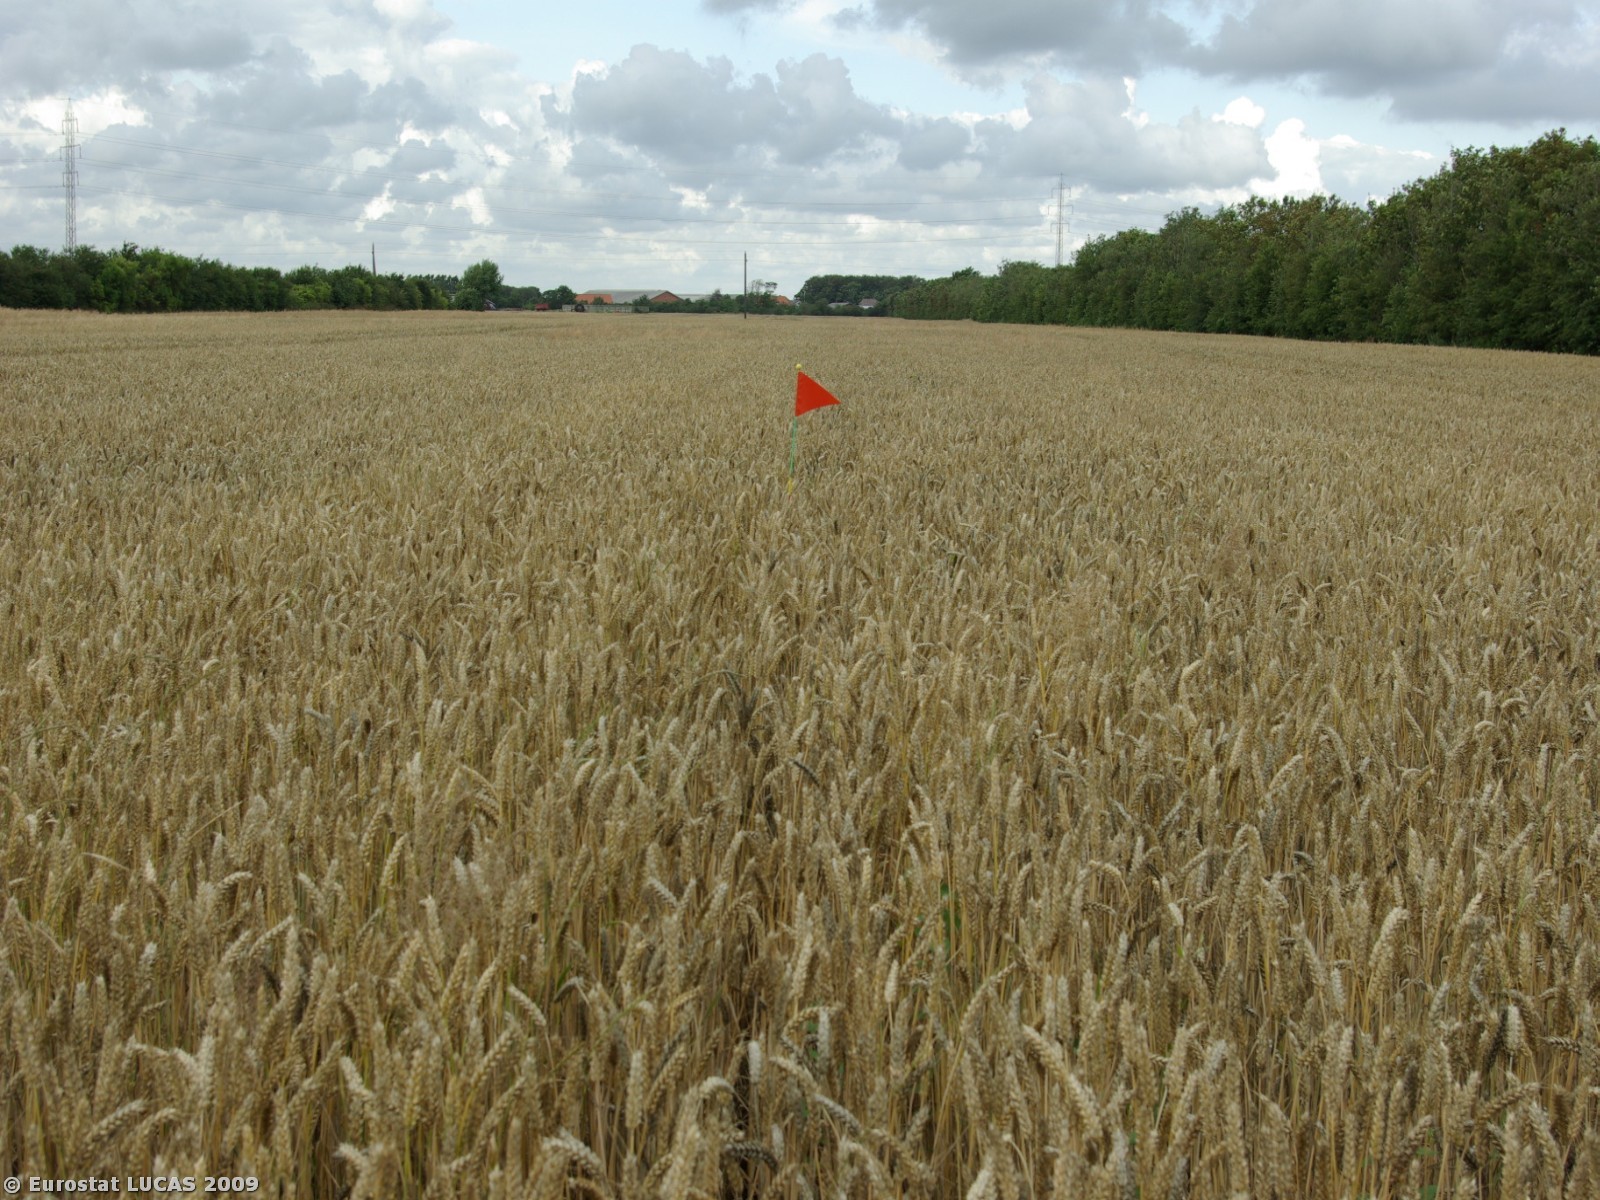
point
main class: Cropland
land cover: Common wheat
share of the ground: > 75 %
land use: Agriculture (excluding fallow land and kitchen gardens)
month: July
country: DK
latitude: 55.0335
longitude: 9.0151
